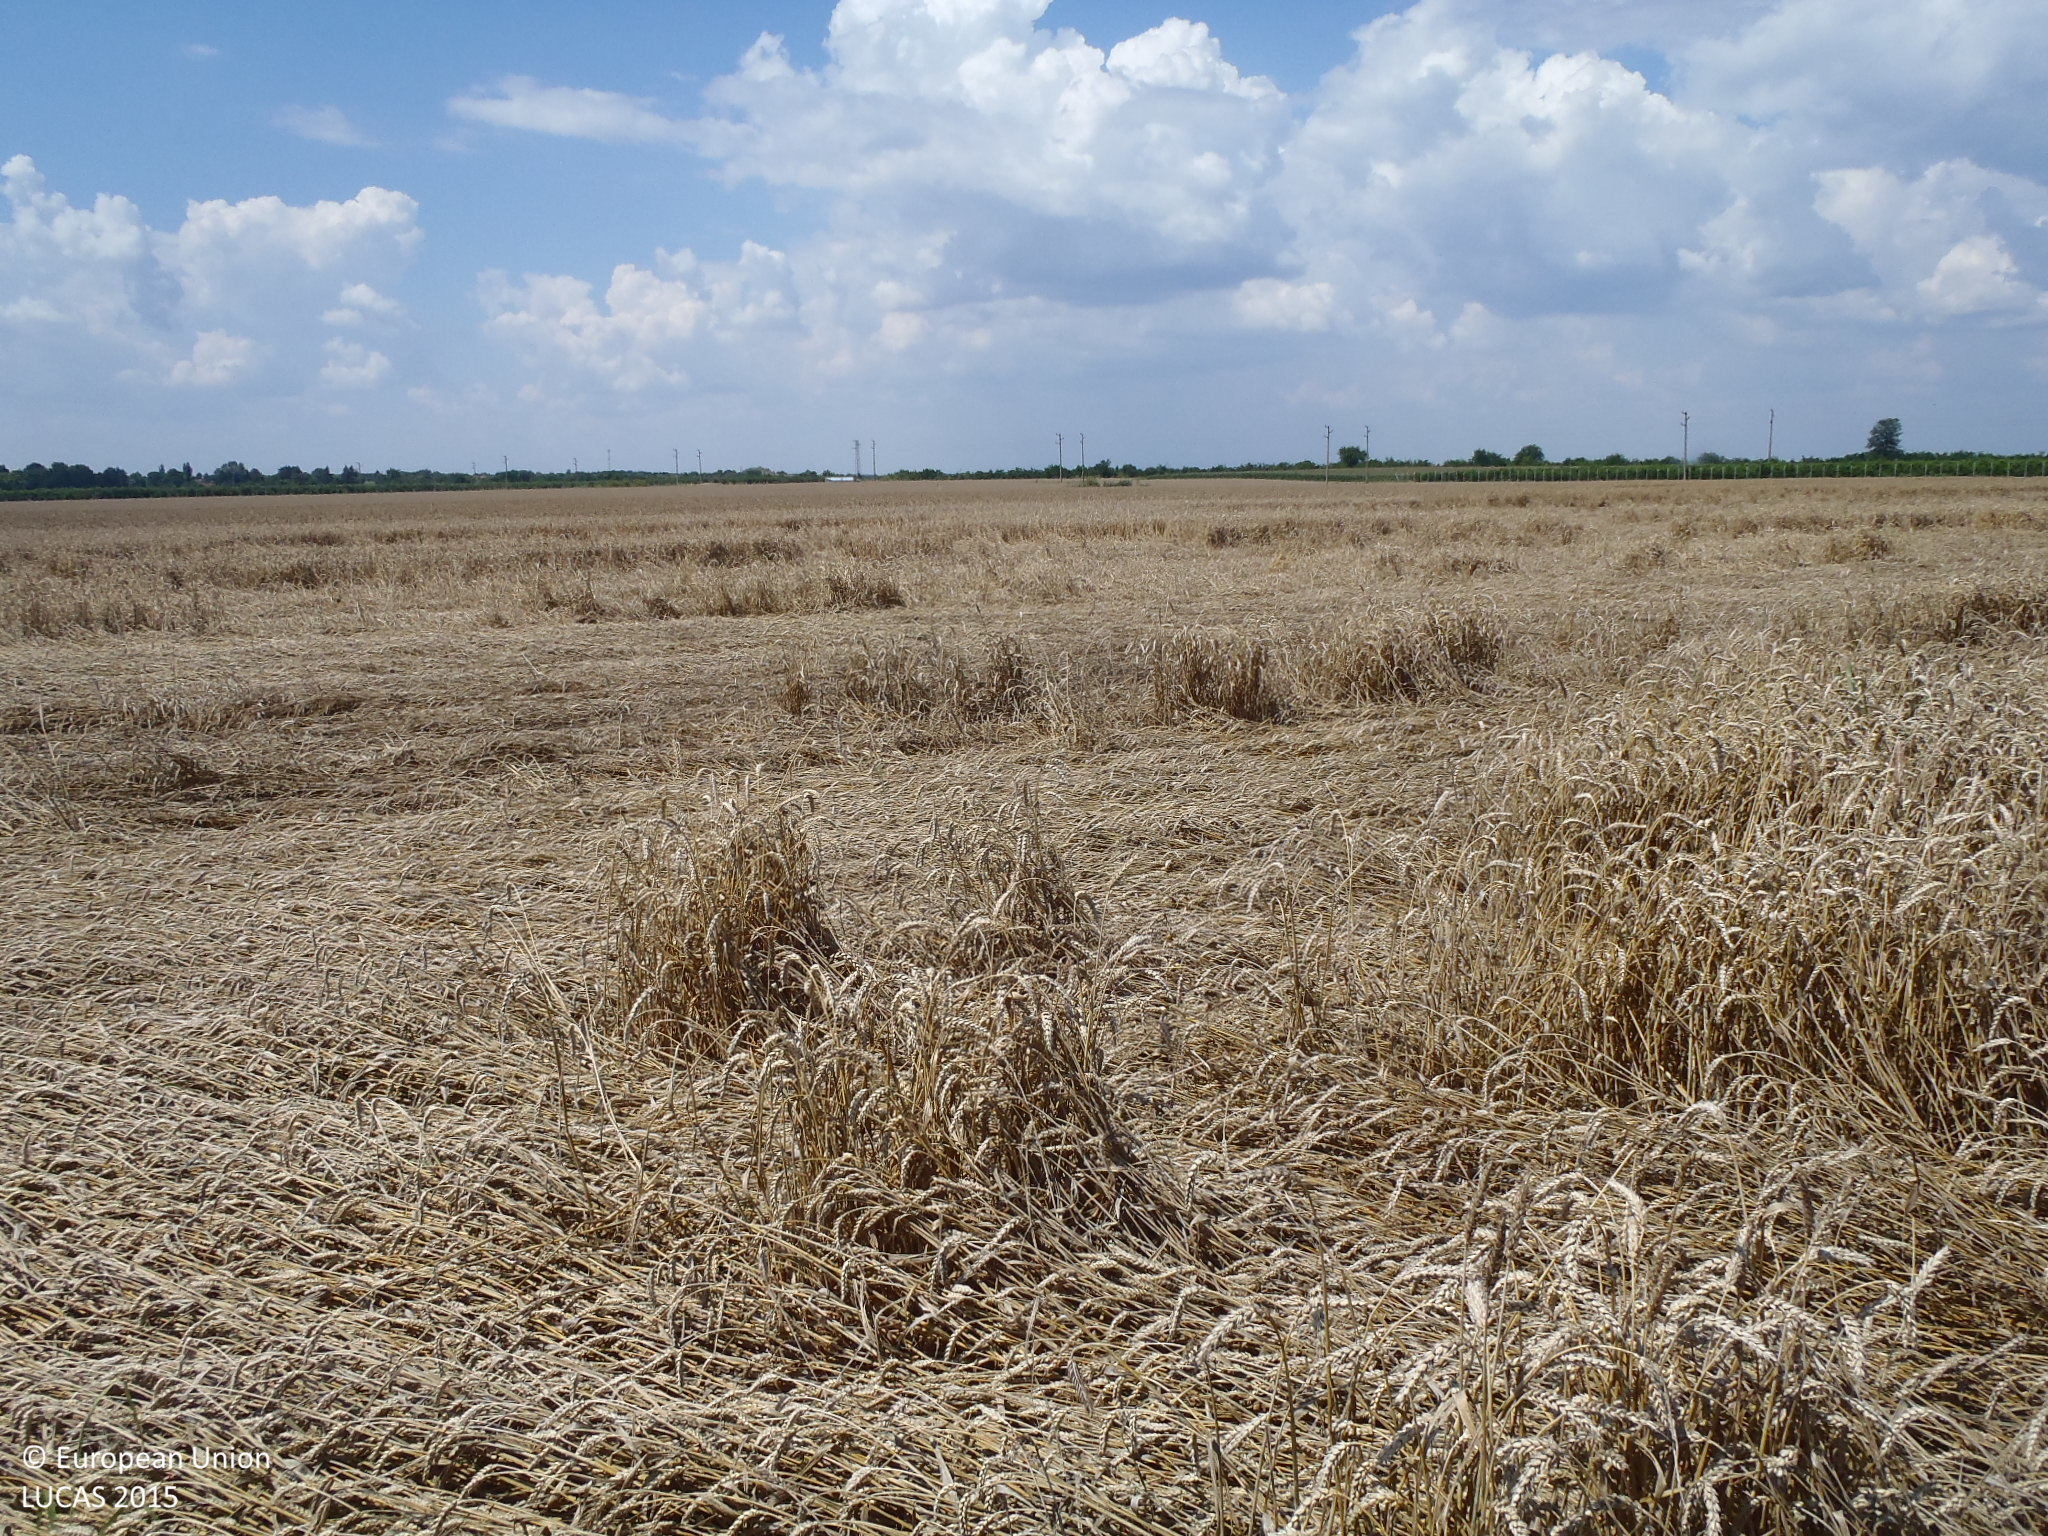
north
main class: Cropland
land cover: Common wheat
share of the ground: > 75 %
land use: Agriculture (excluding fallow land and kitchen gardens)
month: July
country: BG
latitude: 43.9665
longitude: 26.3210
